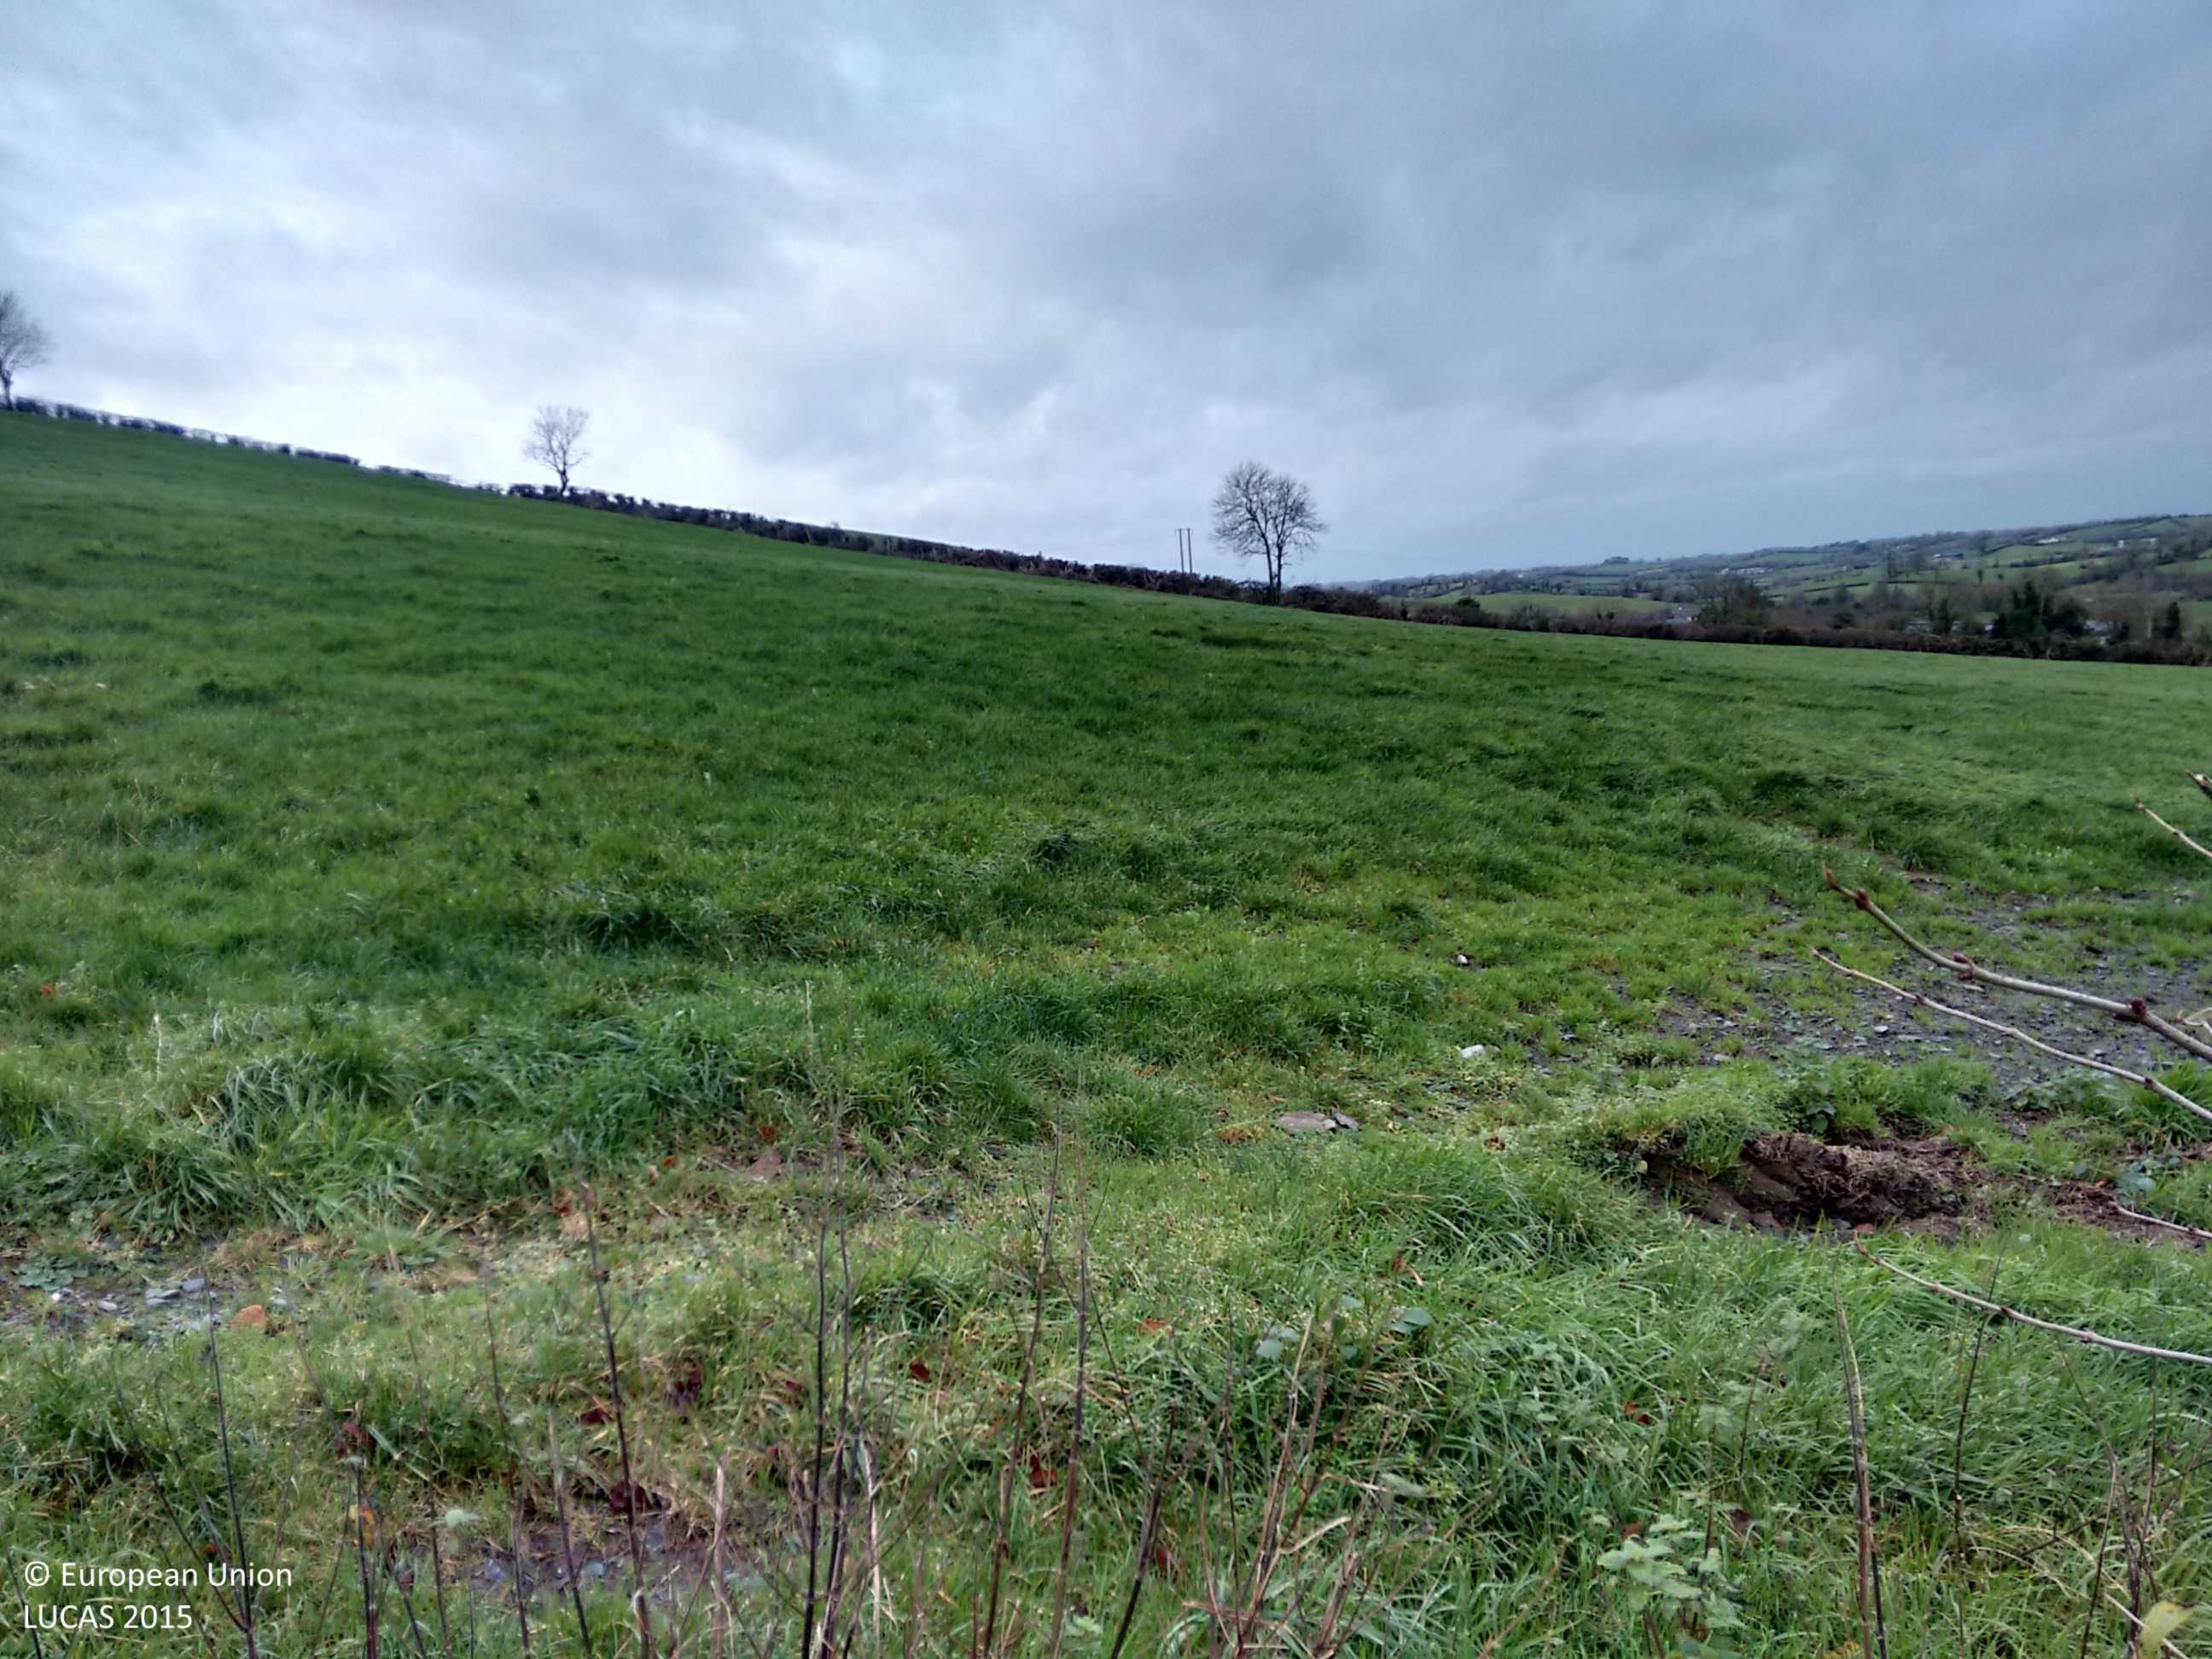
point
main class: Grassland
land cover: Grassland without tree/shrub cover
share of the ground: > 75 %
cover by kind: herbaceous plants 100 %
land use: Agriculture (excluding fallow land and kitchen gardens)
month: December
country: IE
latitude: 54.1124
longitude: -6.9188
